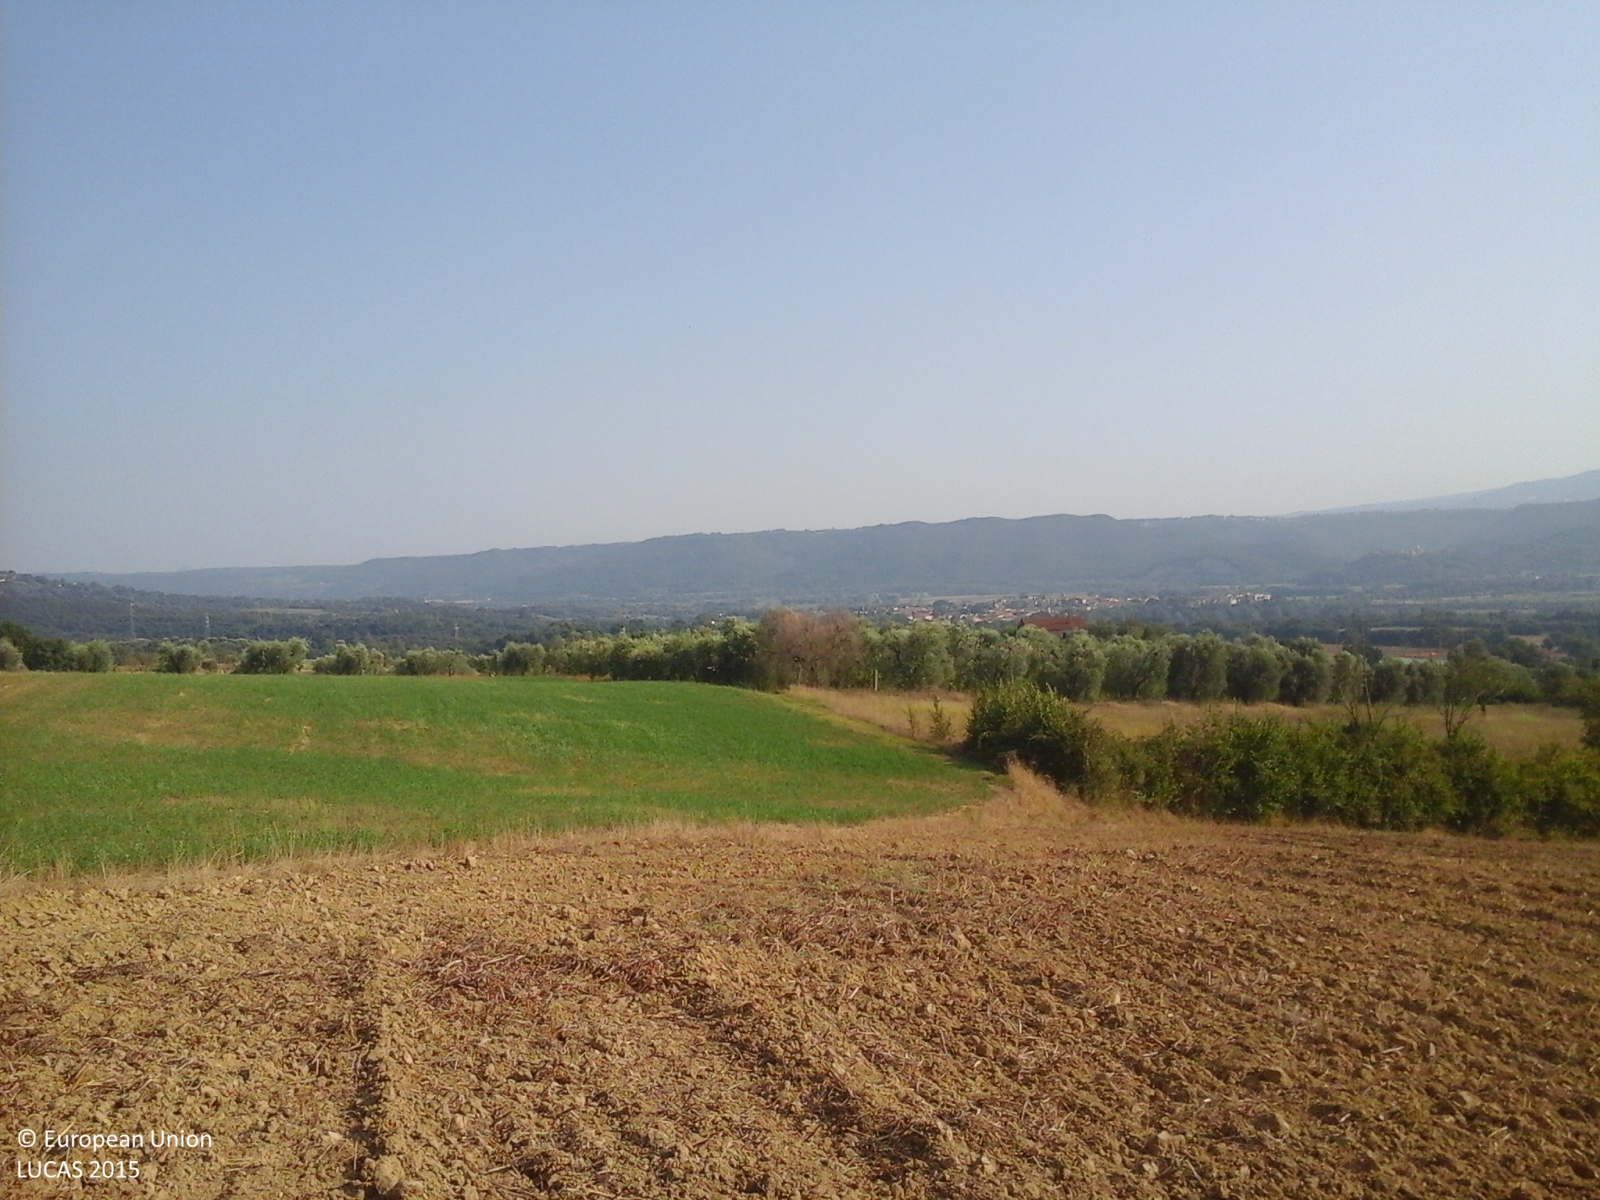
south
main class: Cropland
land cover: Sunflower
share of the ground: 10 - 25 %
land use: Agriculture (excluding fallow land and kitchen gardens)
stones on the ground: < 10 %
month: August
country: IT
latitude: 42.5377
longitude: 12.2937
